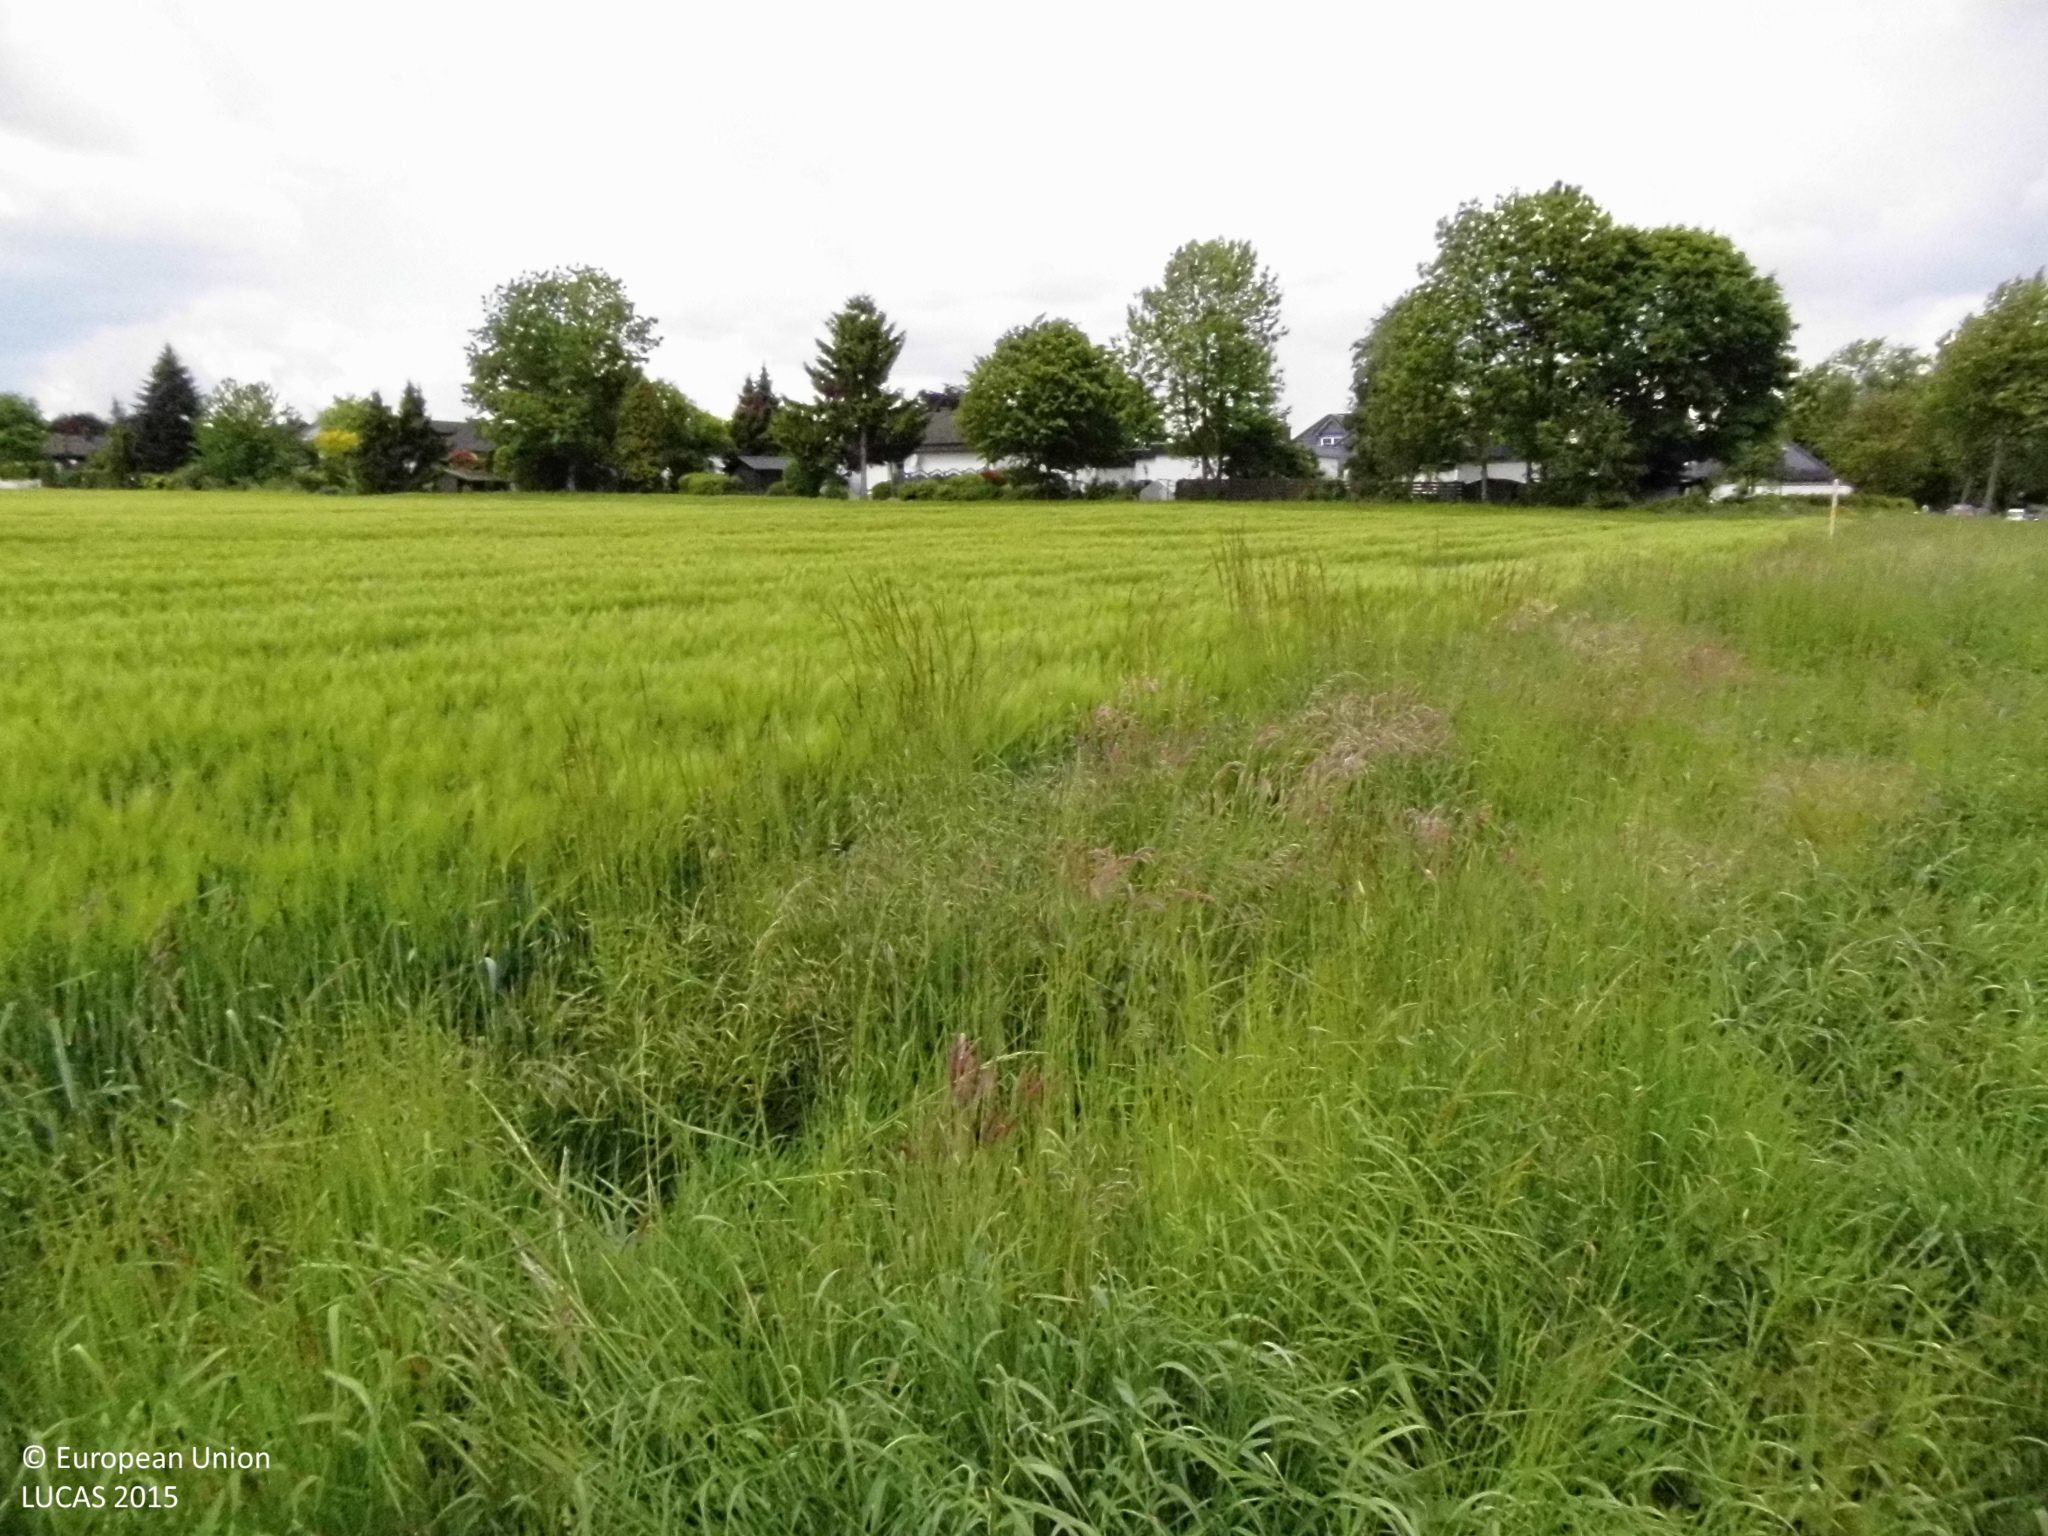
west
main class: Grassland
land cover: Spontaneously vegetated surfaces
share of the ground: > 75 %
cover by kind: herbaceous plants 100 %
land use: Semi-natural and natural areas not in use
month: May
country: DE
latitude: 51.5773
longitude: 7.4750
